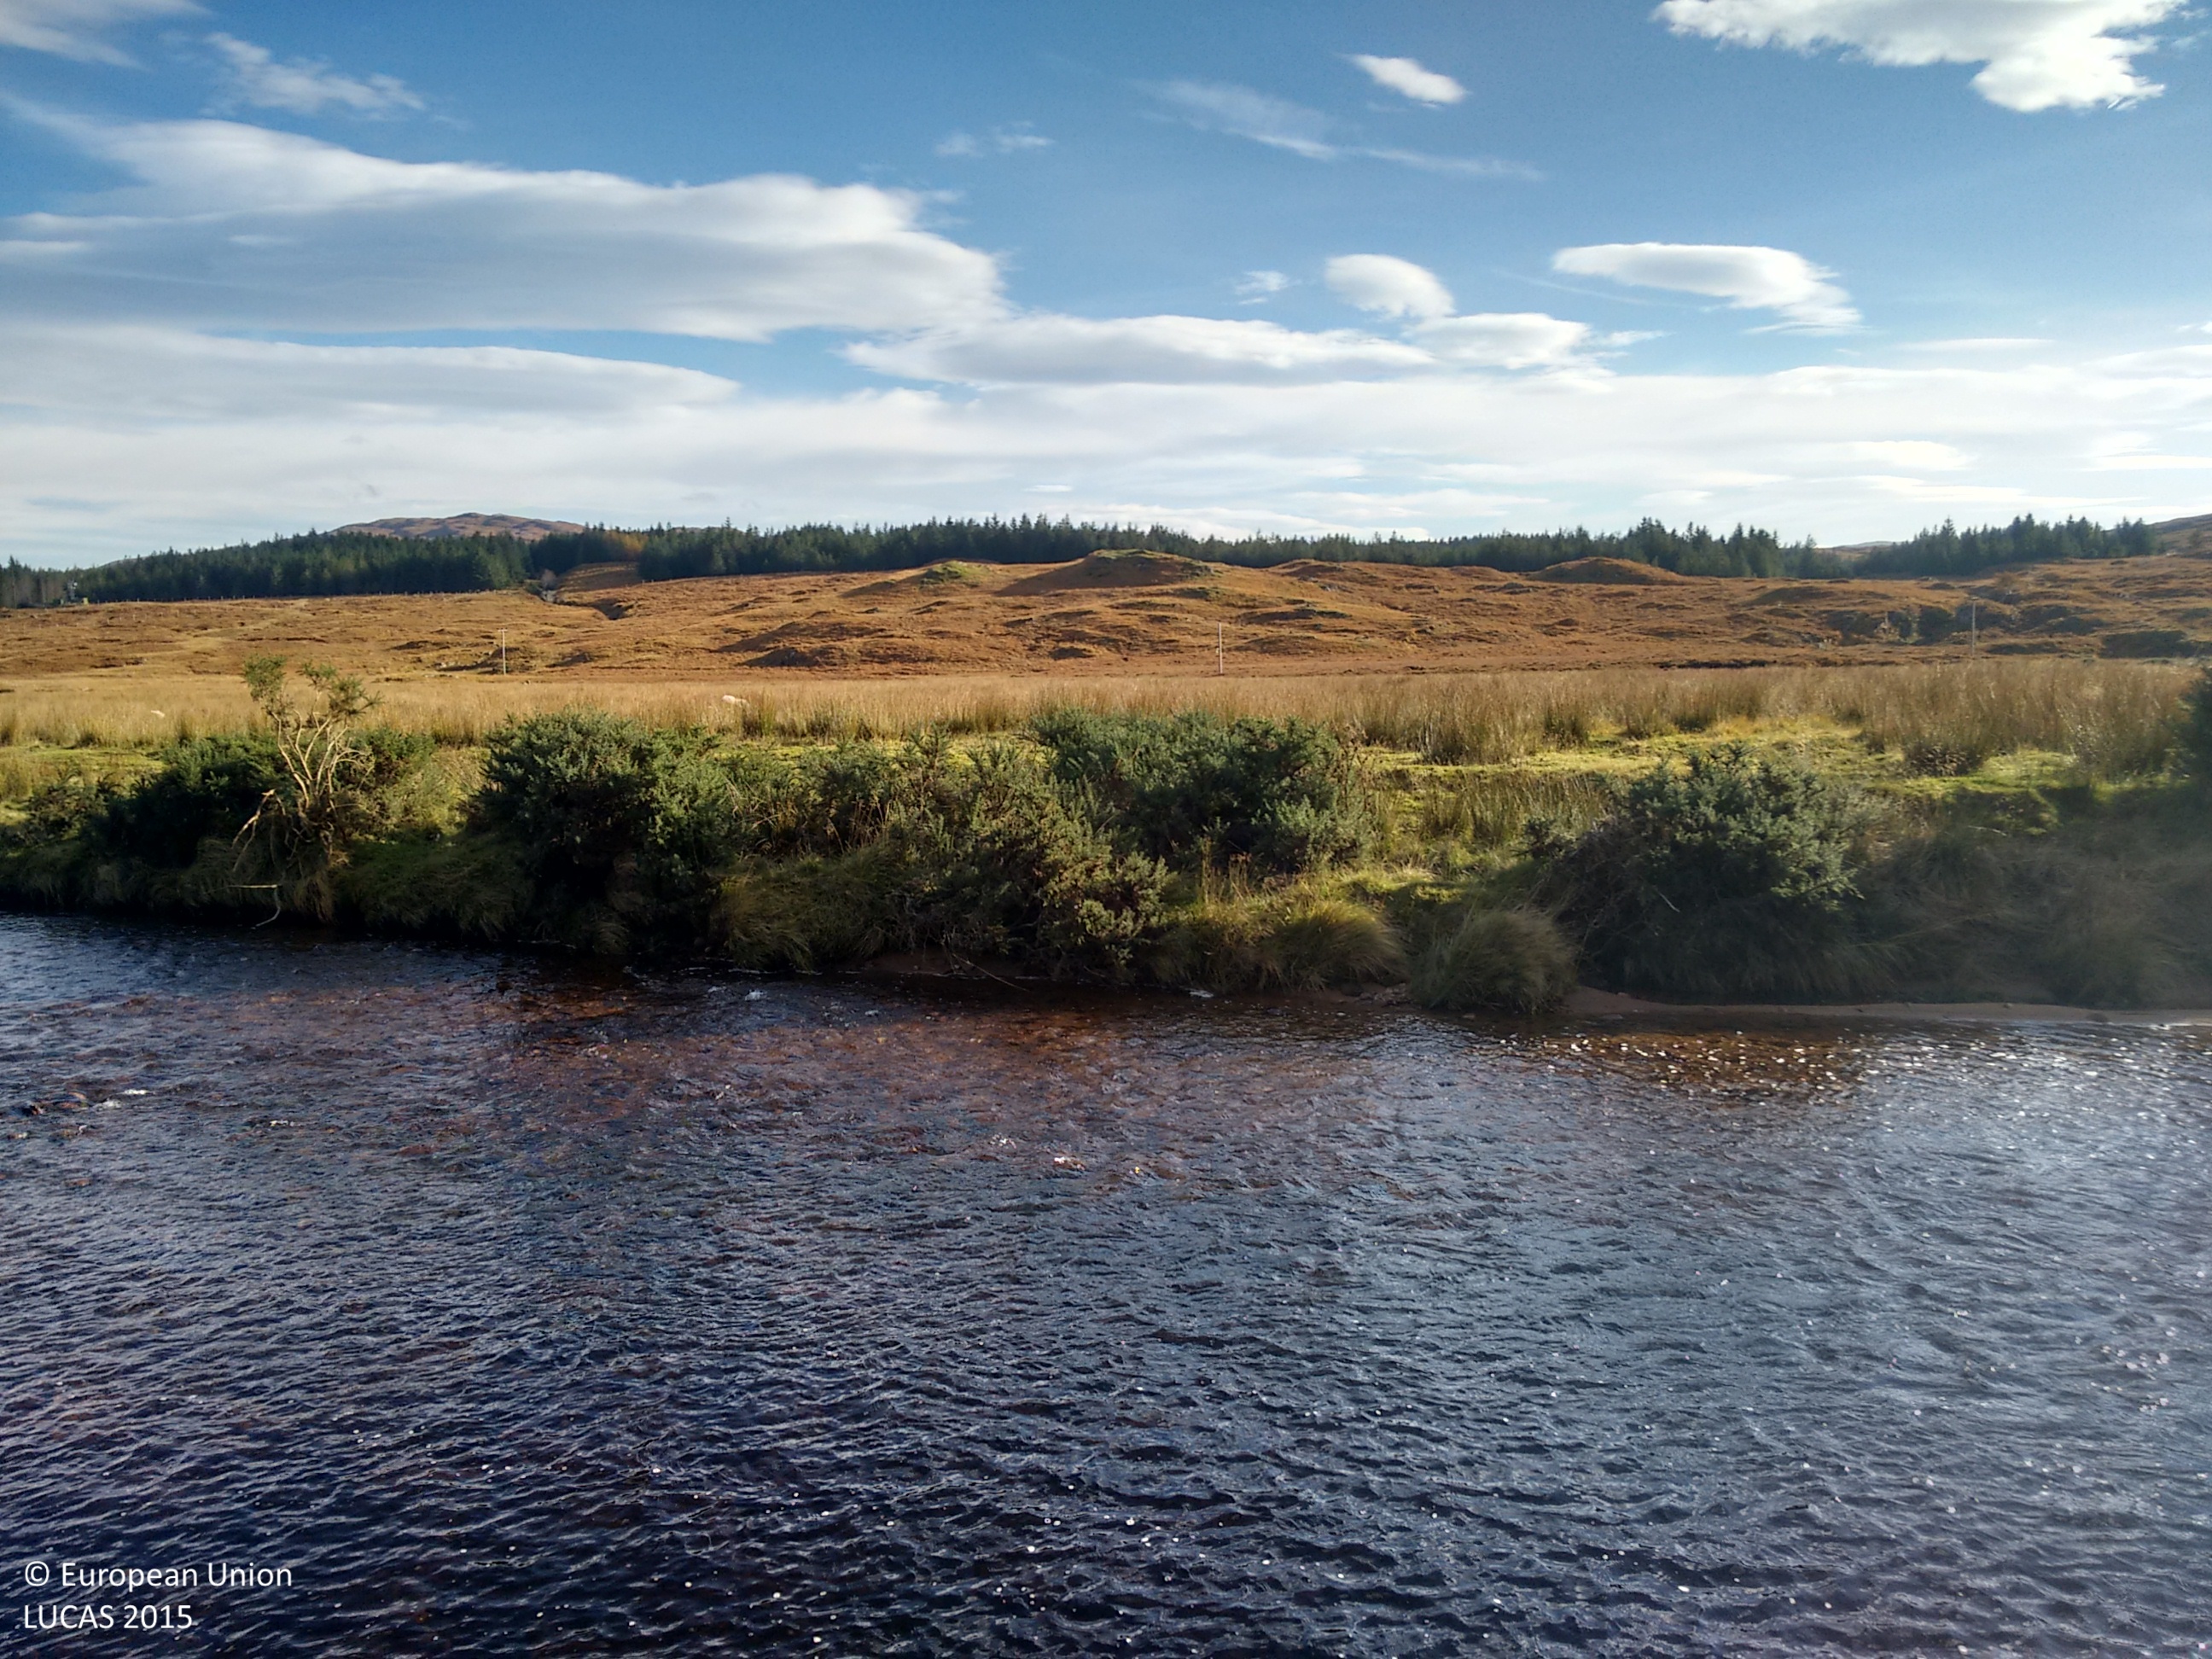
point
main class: Grassland
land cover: Grassland without tree/shrub cover
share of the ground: > 75 %
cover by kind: herbaceous plants 100 %
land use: Agriculture (excluding fallow land and kitchen gardens)
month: October
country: GB
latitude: 56.5925
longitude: -5.6765
